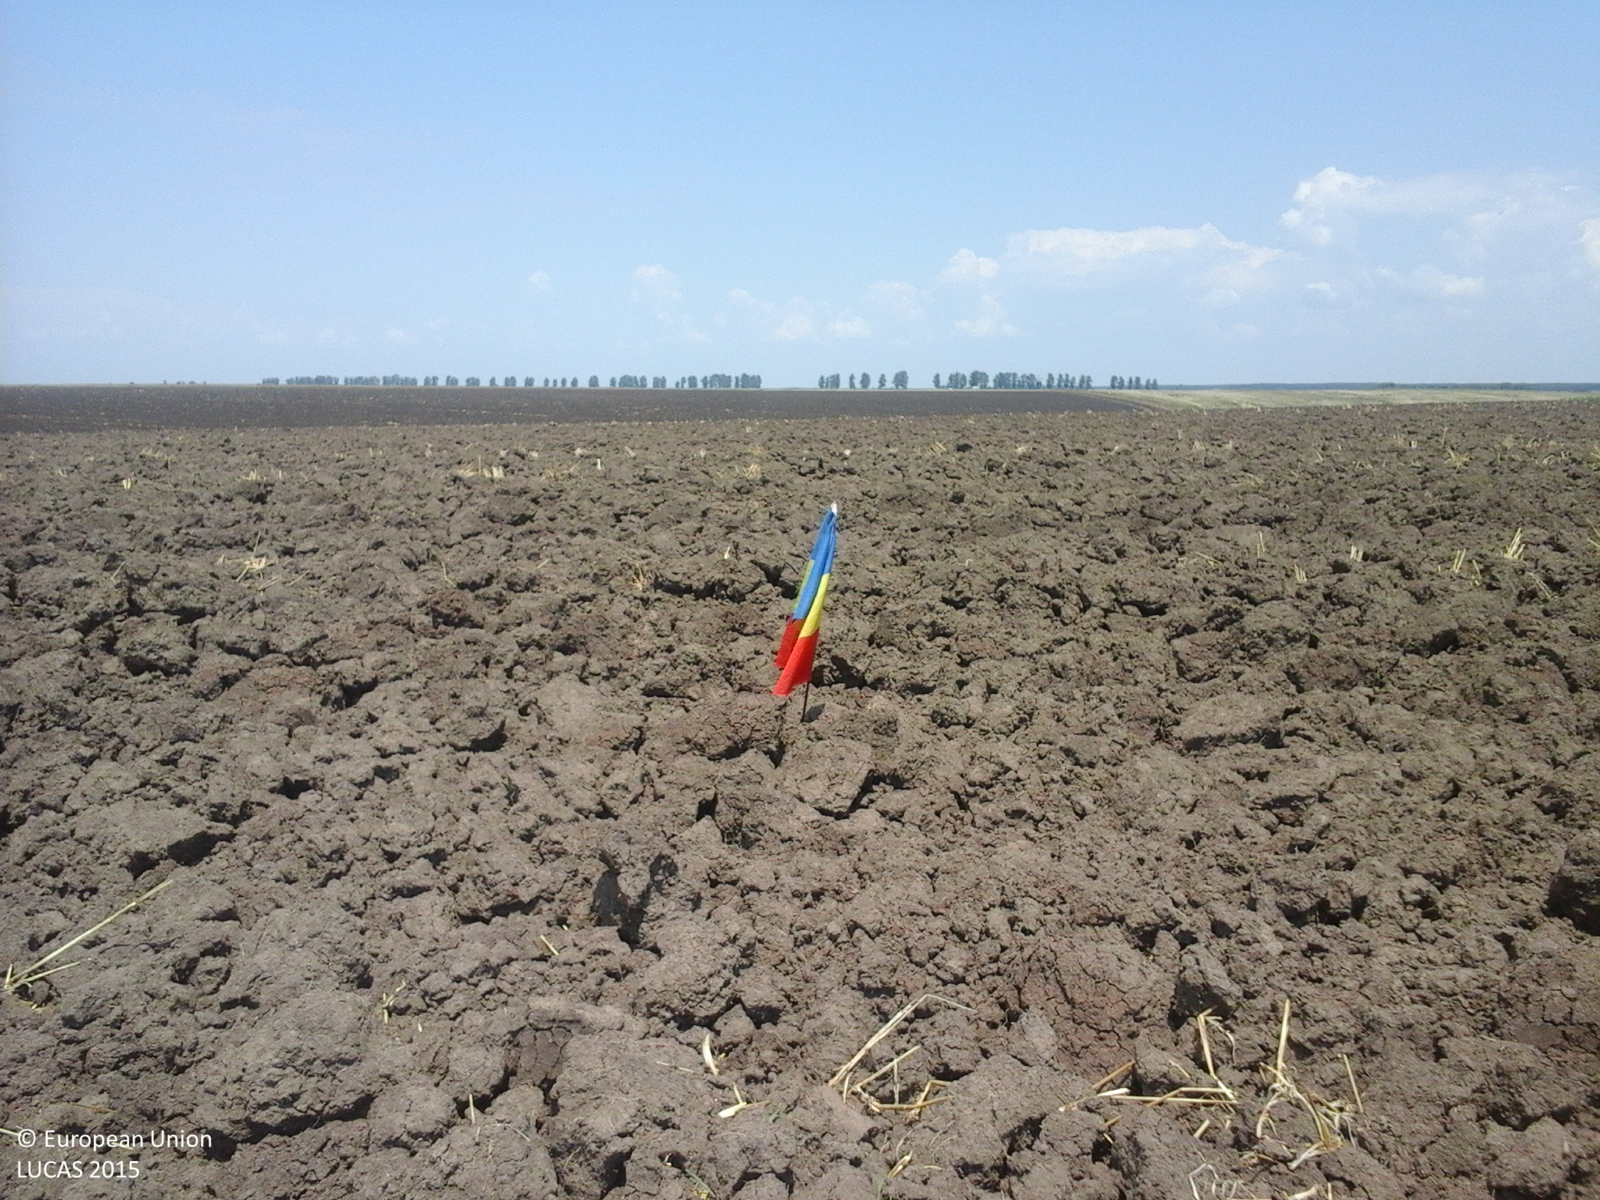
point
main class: Cropland
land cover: Common wheat
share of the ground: < 10 %
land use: Agriculture (excluding fallow land and kitchen gardens)
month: July
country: RO
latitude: 44.0900
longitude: 25.7684
